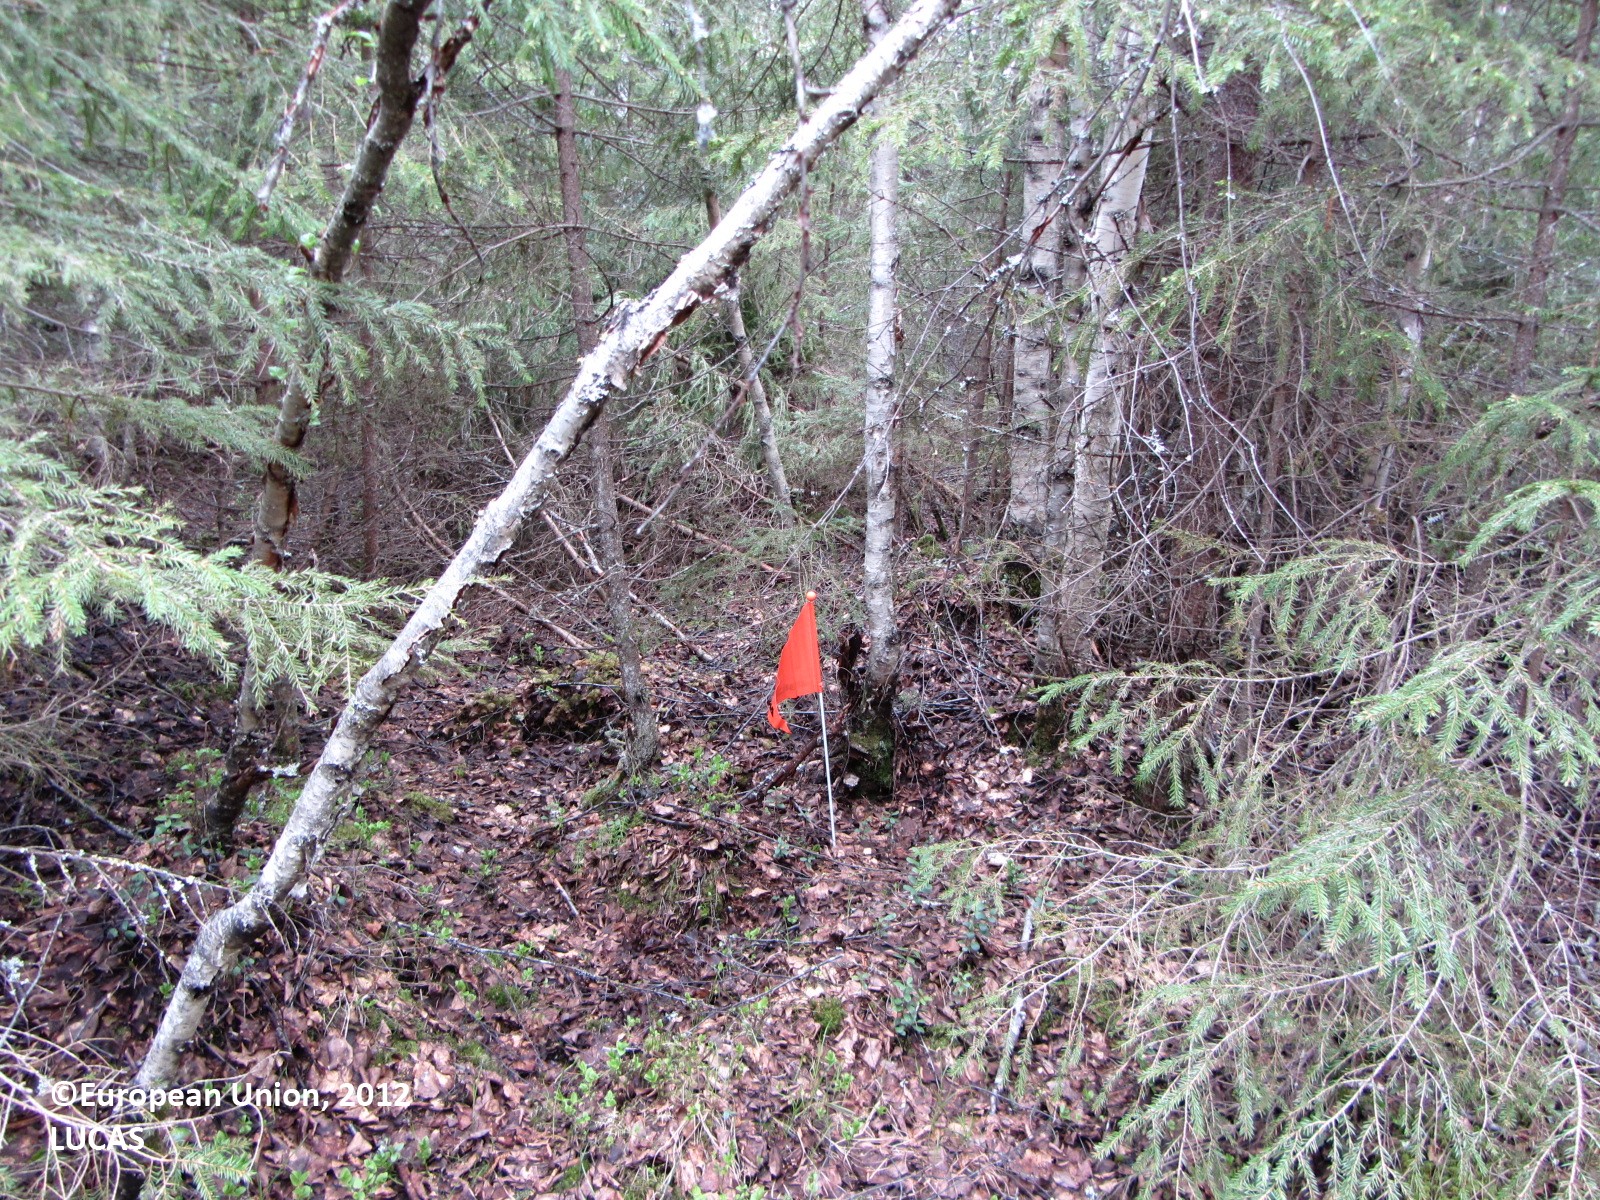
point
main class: Woodland
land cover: Spruce dominated mixed woodland
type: boreal forest
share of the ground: > 75 %
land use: Forestry
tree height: > 5 m
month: June
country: FI
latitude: 63.7951
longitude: 24.7570
